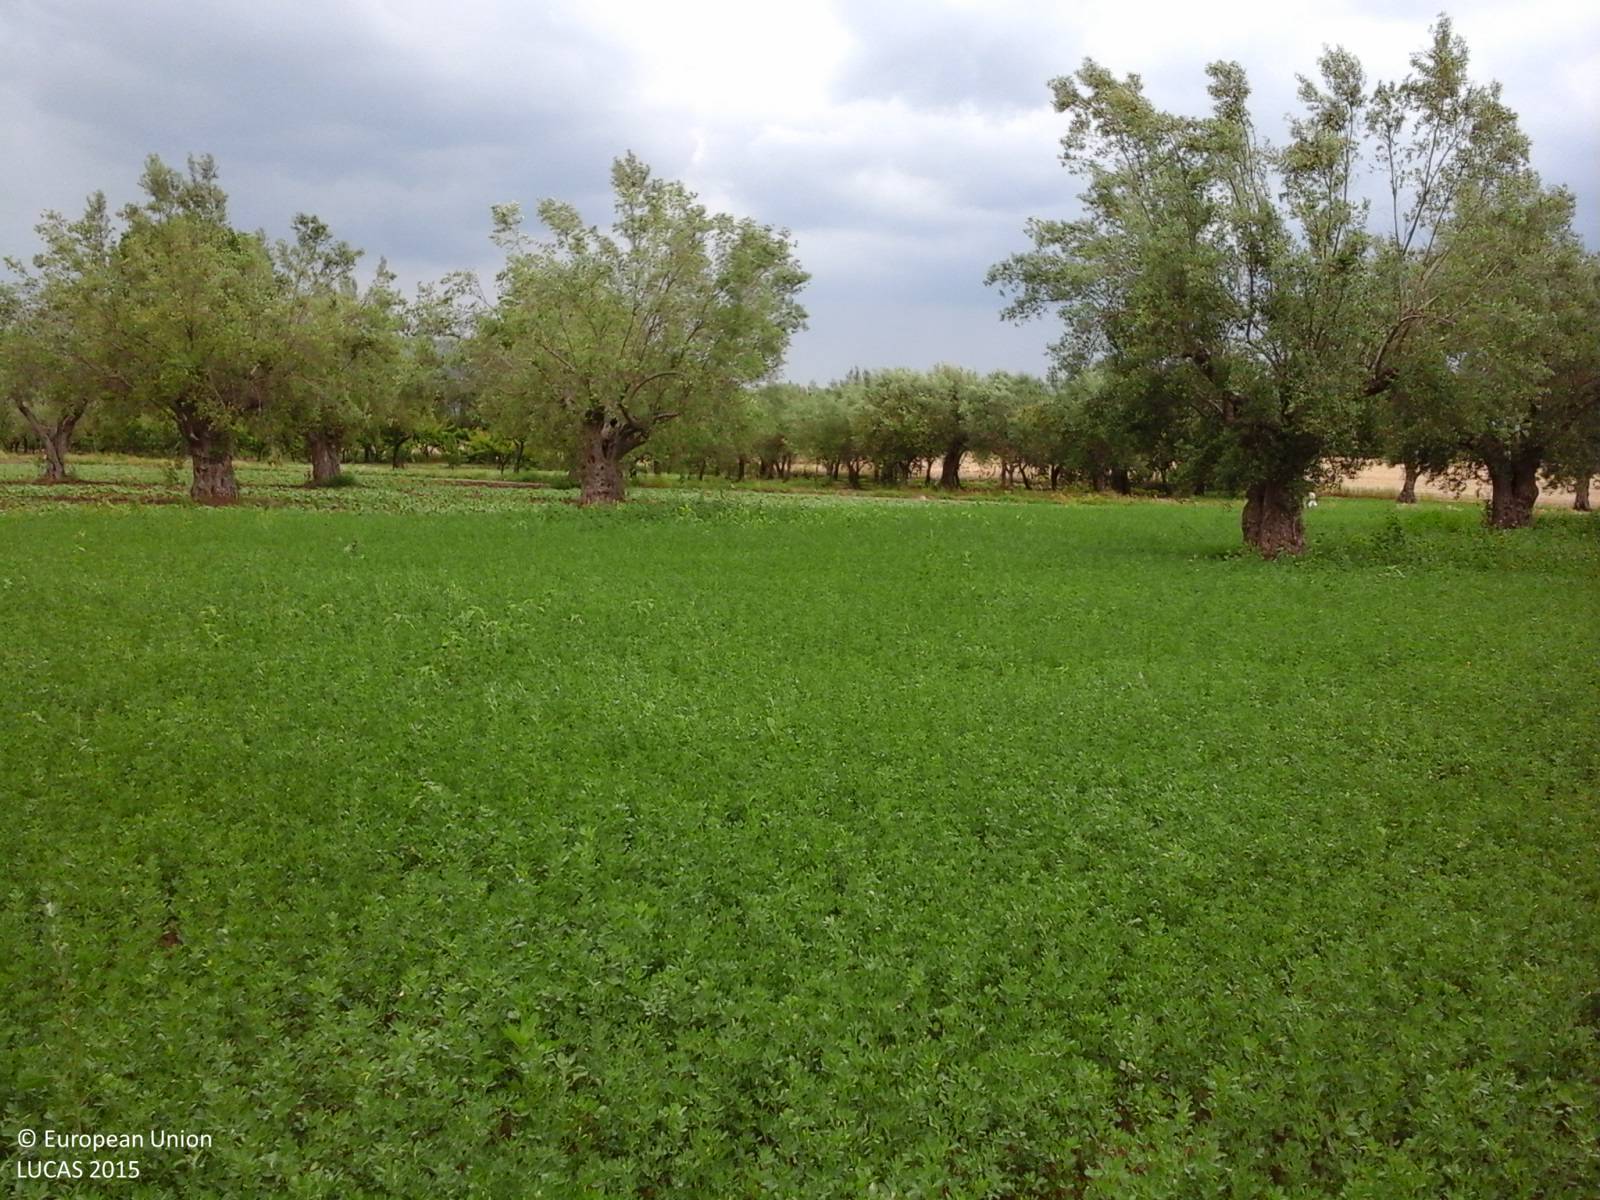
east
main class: Cropland
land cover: Lucerne
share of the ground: > 75 %
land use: Agriculture (excluding fallow land and kitchen gardens)
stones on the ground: < 10 %
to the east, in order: Lucerne; Grass margins; Paved roads, cycling and walking lanes; Olive groves; Common wheat; Grass margins; Tracks; Spontaneously vegetated surfaces; Cherry fruit
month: May
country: IT
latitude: 41.1560
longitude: 14.1900
